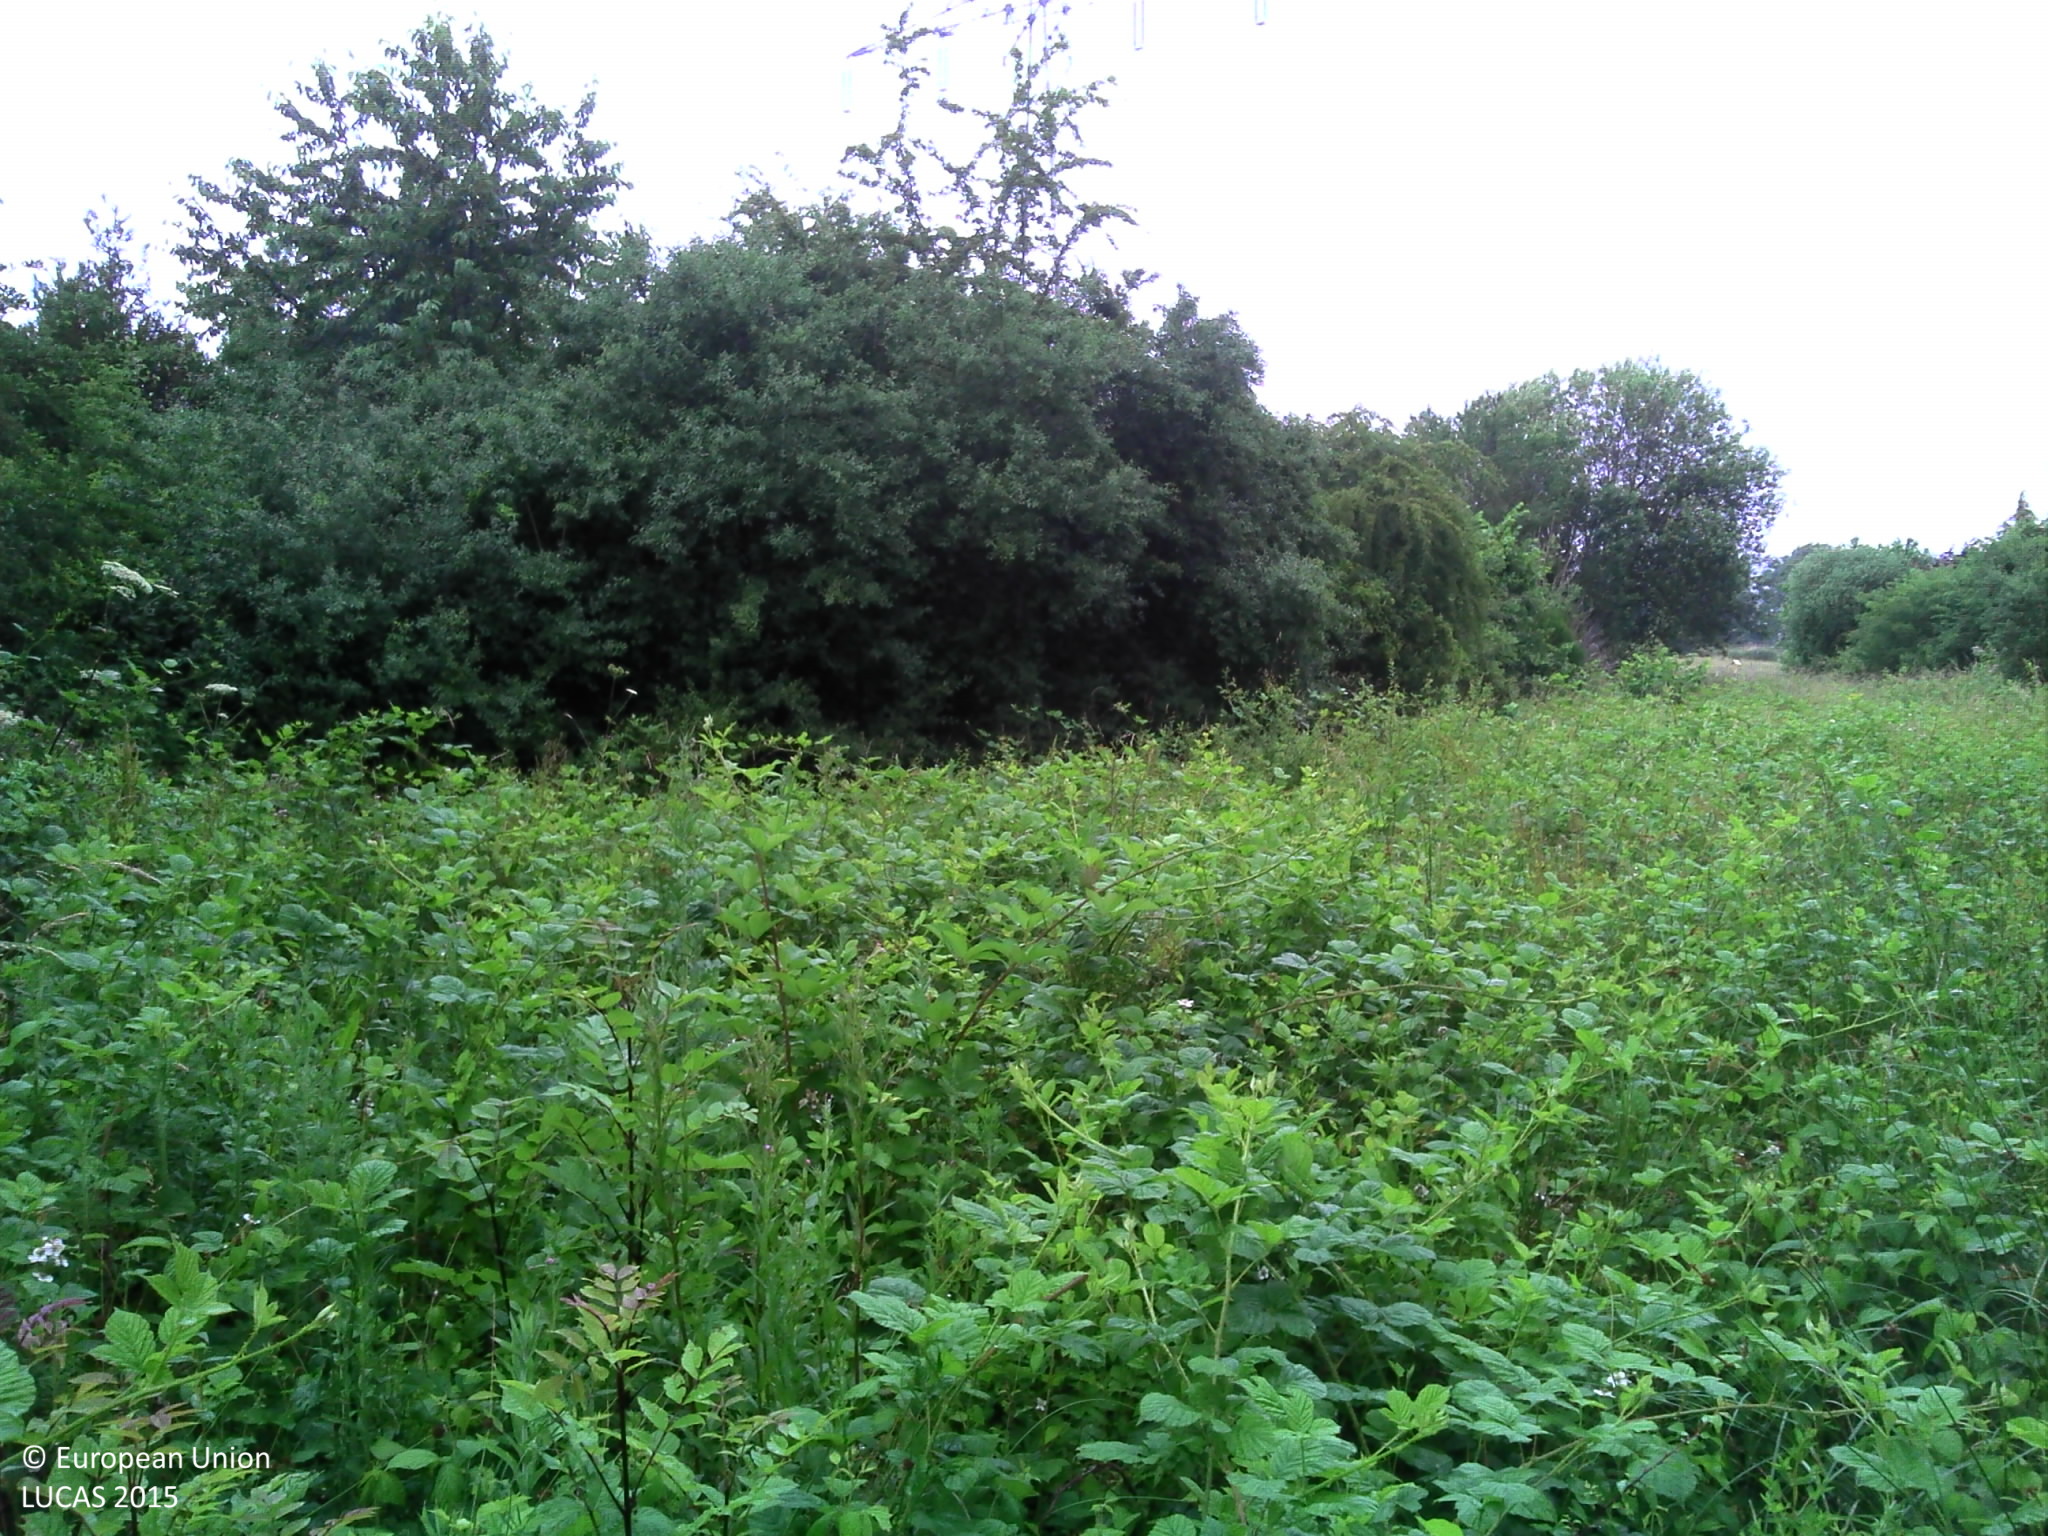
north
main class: Shrubland
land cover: Shrubland without tree cover
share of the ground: > 75 %
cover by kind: shrubs 90 %, herbaceous plants 10 %
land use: Semi-natural and natural areas not in use
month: June
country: FR
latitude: 48.6458
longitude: 6.2405
